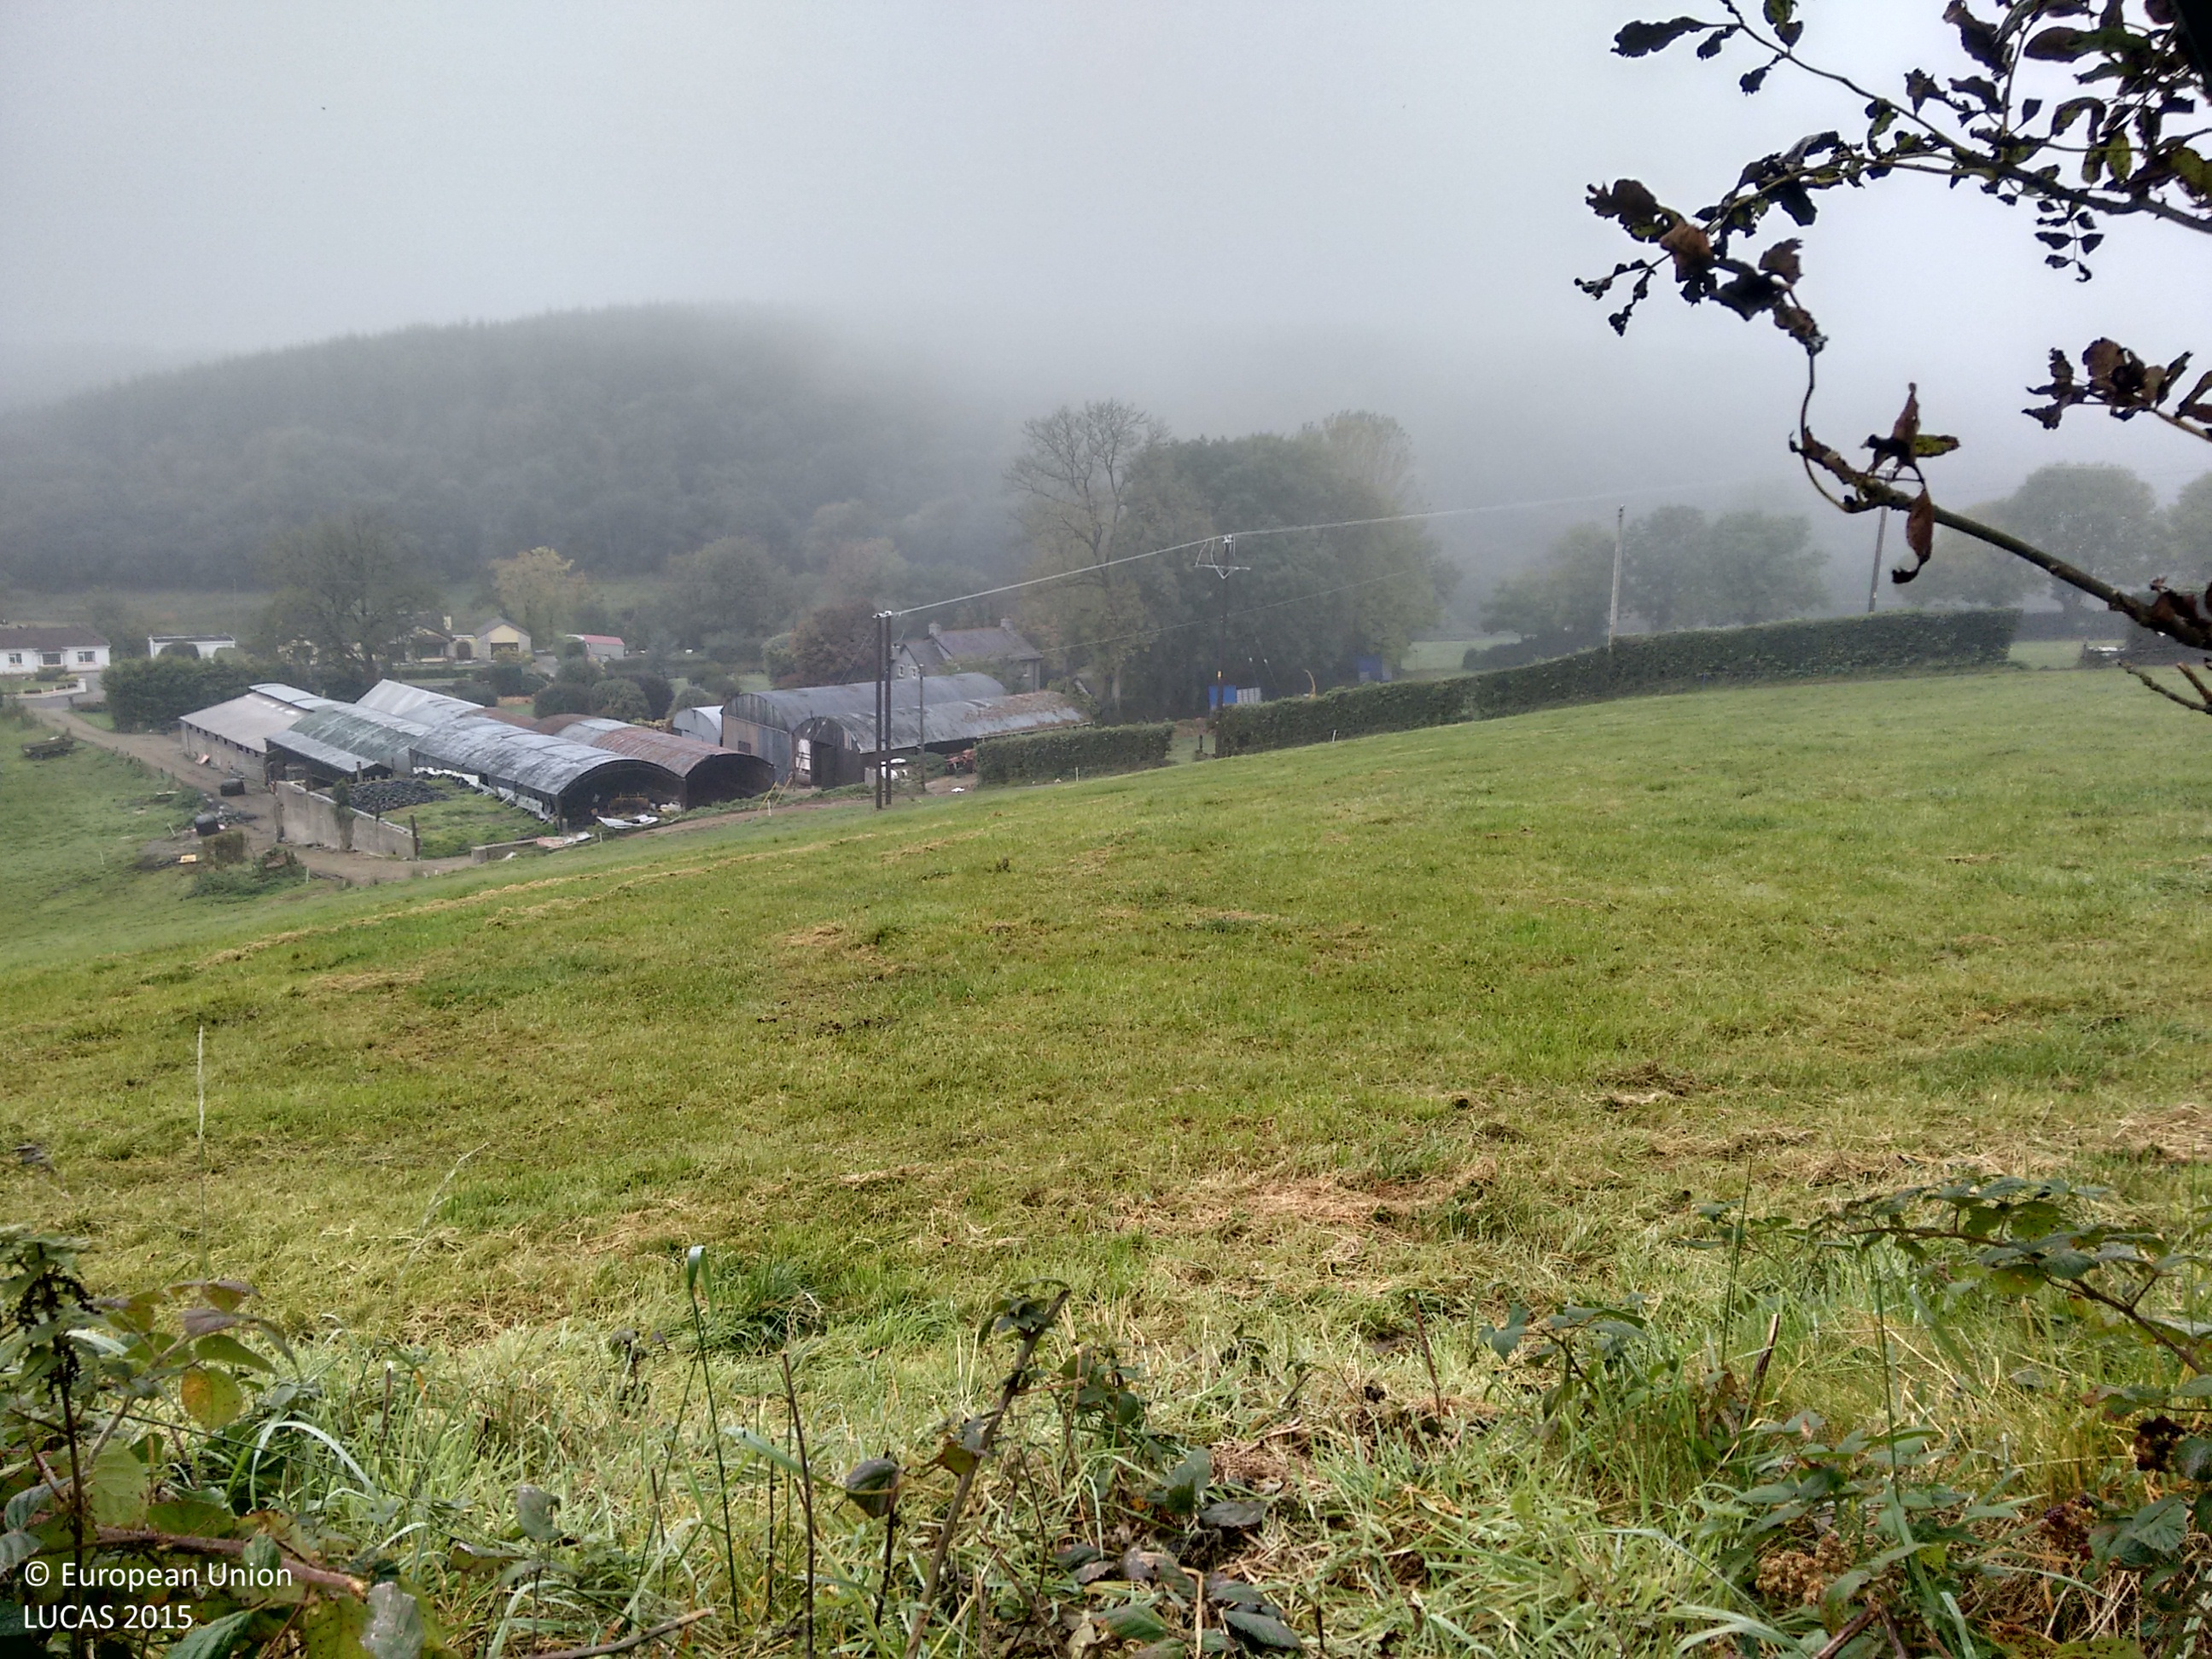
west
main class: Grassland
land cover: Grassland without tree/shrub cover
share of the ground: > 75 %
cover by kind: herbaceous plants 100 %
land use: Agriculture (excluding fallow land and kitchen gardens)
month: October
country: GB
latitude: 54.4091
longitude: -7.8077
